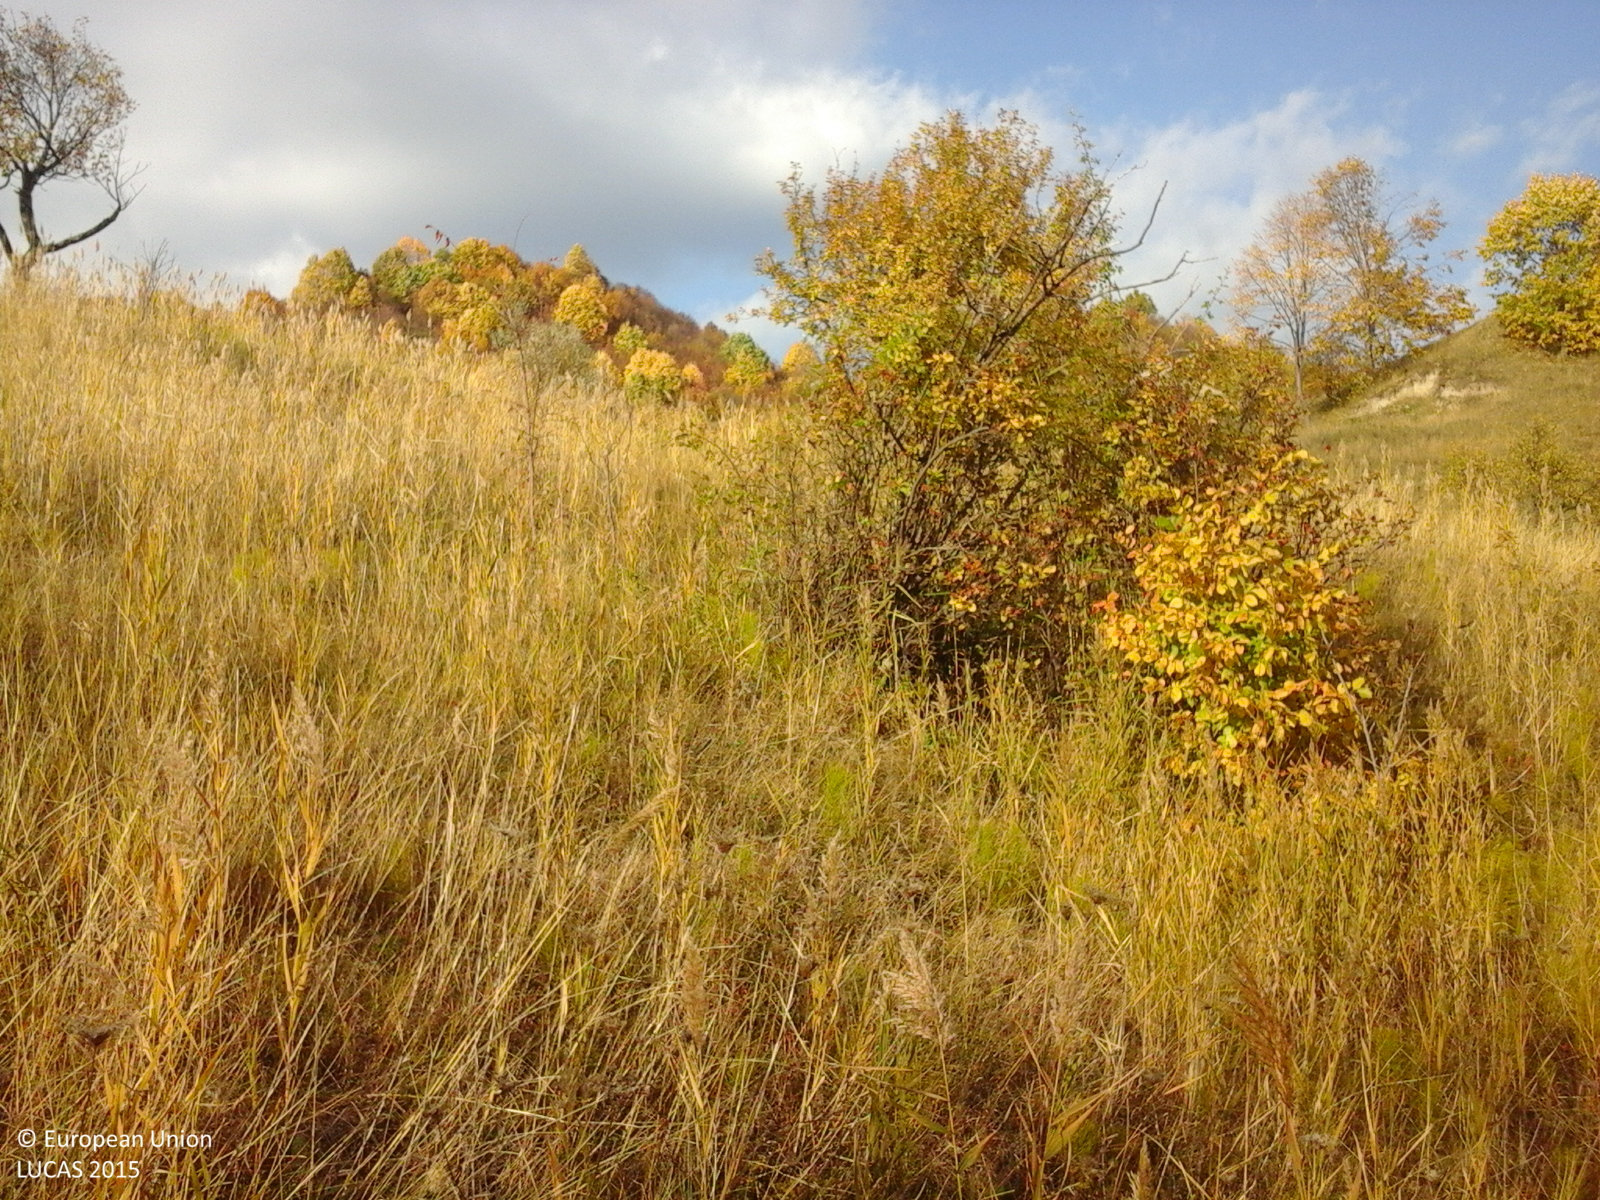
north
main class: Grassland
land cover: Grassland with sparse tree/shrub cover
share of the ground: > 75 %
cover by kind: herbaceous plants 85 %, shrubs 10 %, broadleaved forest trees 5 %
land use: Agriculture (excluding fallow land and kitchen gardens)
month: October
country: RO
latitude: 45.4629
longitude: 26.6135
